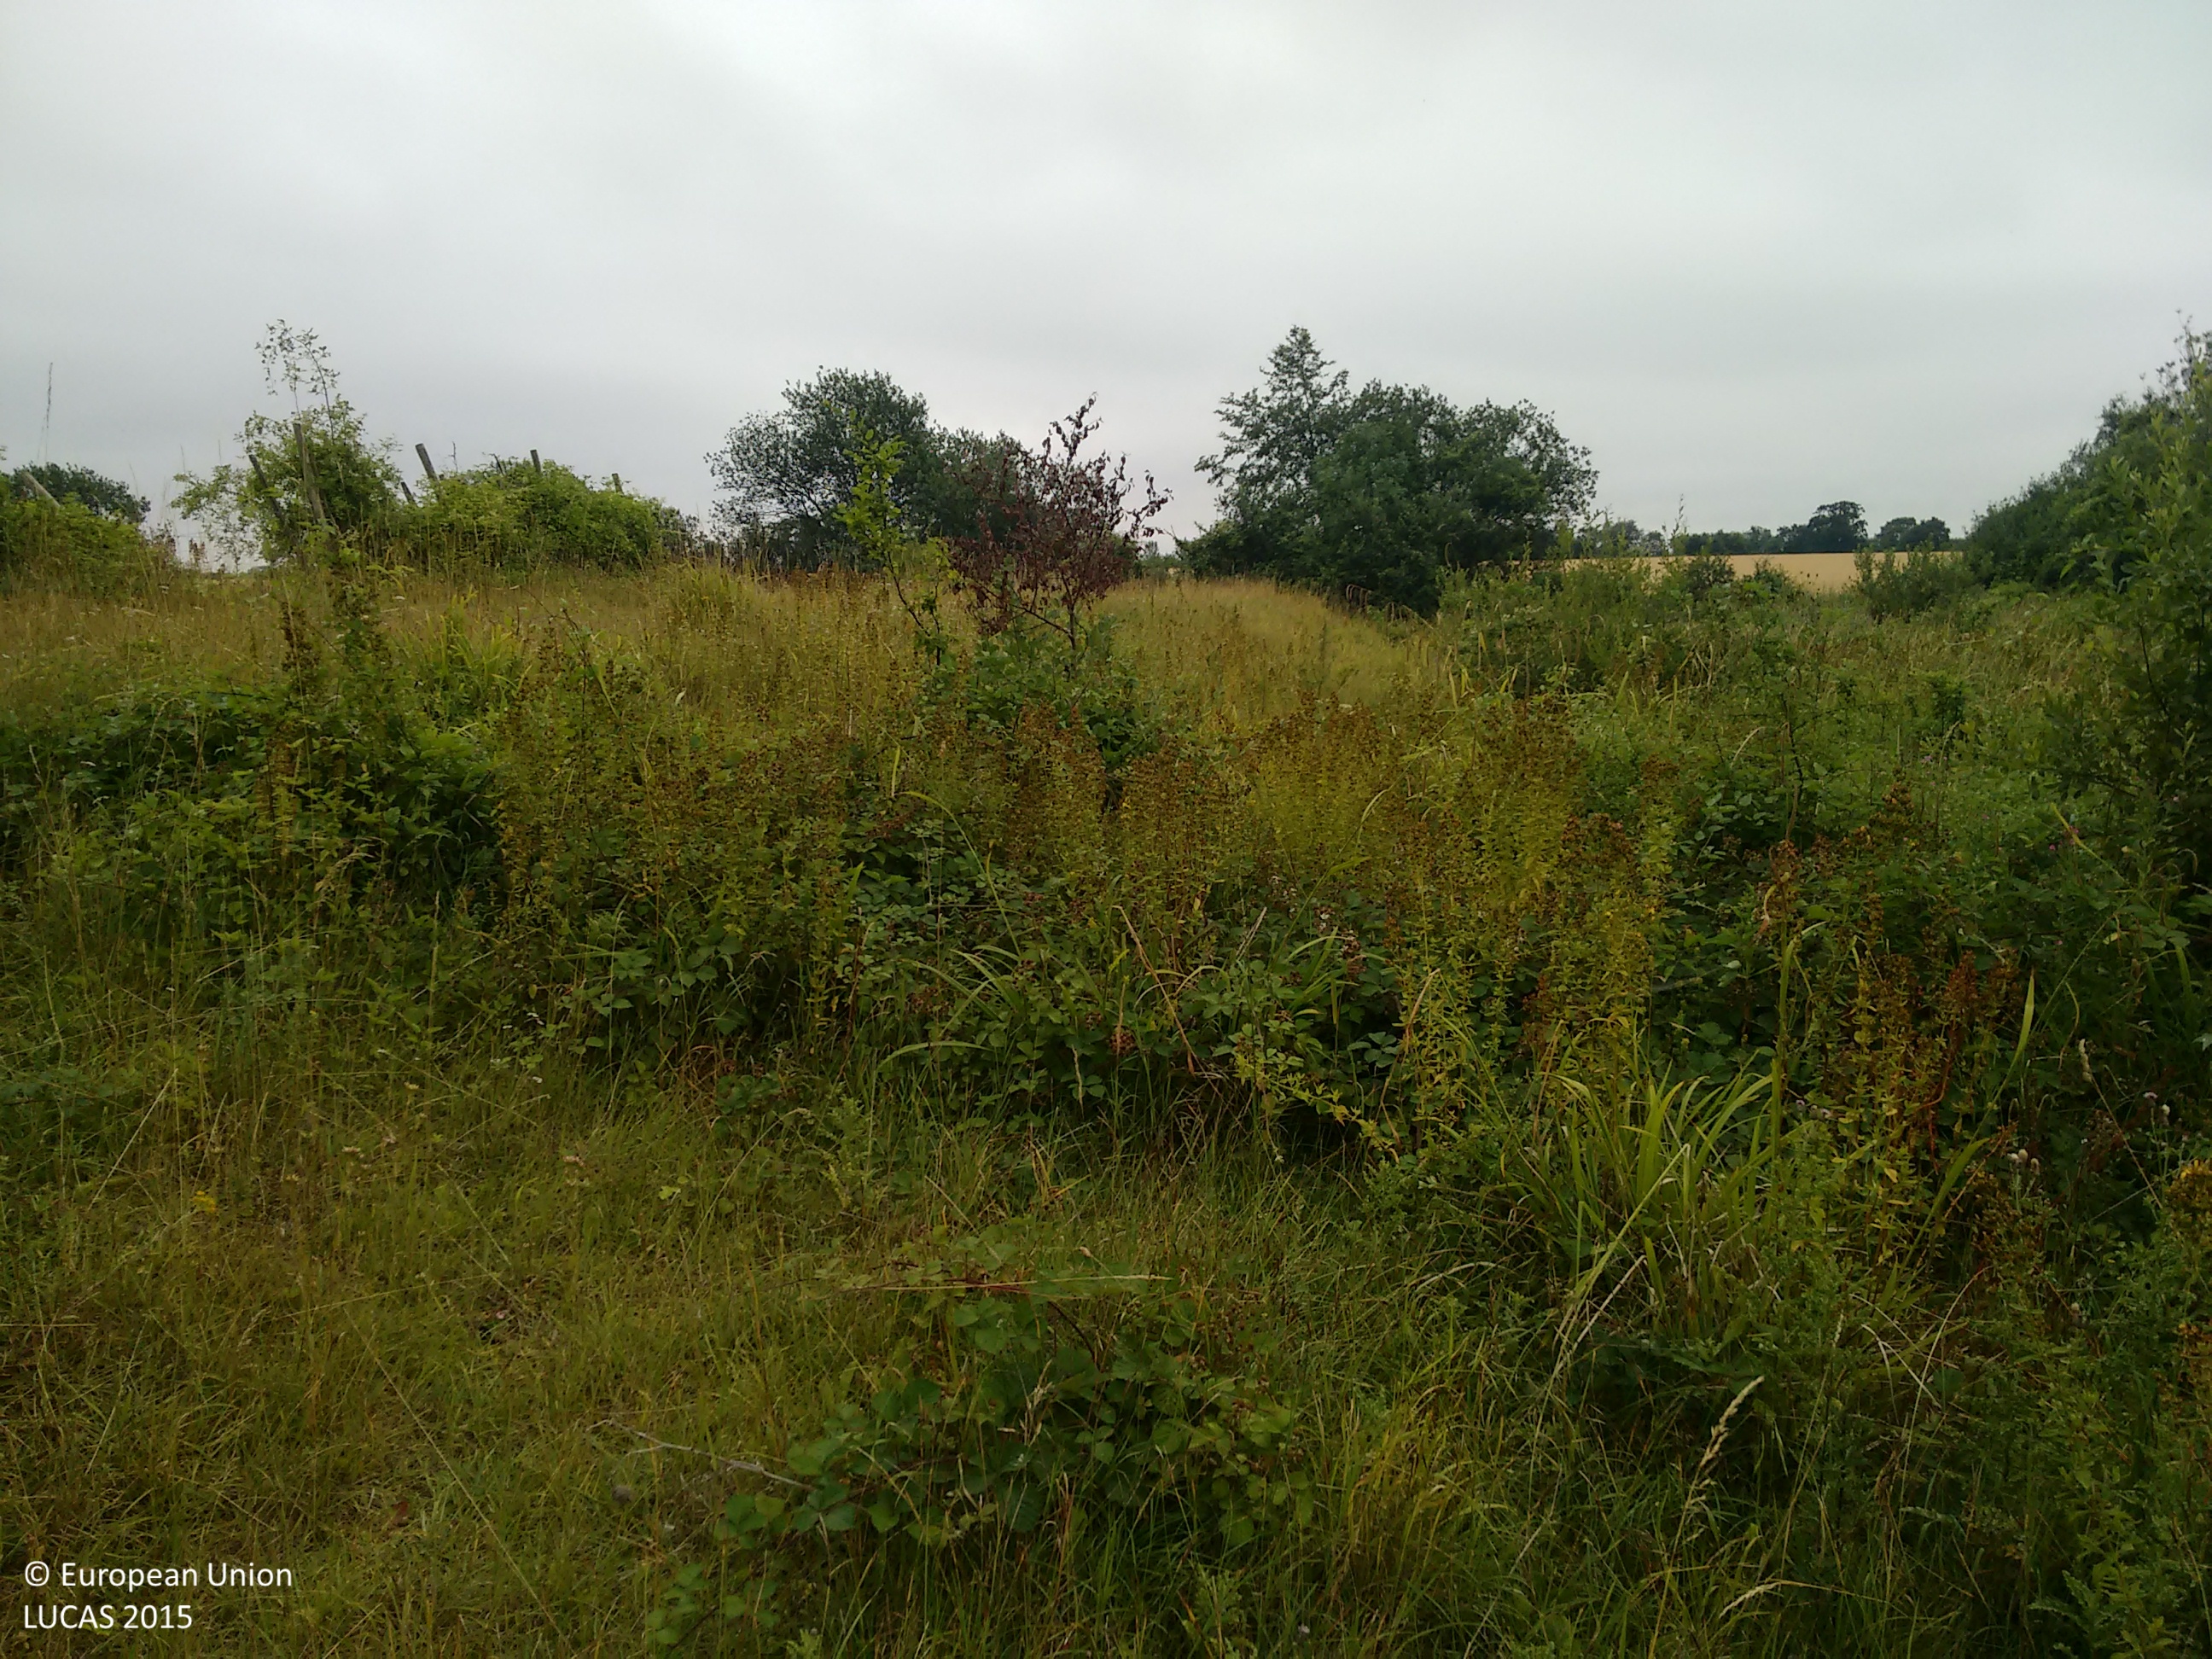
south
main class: Grassland
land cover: Grassland without tree/shrub cover
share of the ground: > 75 %
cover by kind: herbaceous plants 100 %
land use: Semi-natural and natural areas not in use
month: July
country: GB
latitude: 51.8135
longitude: 0.2657
